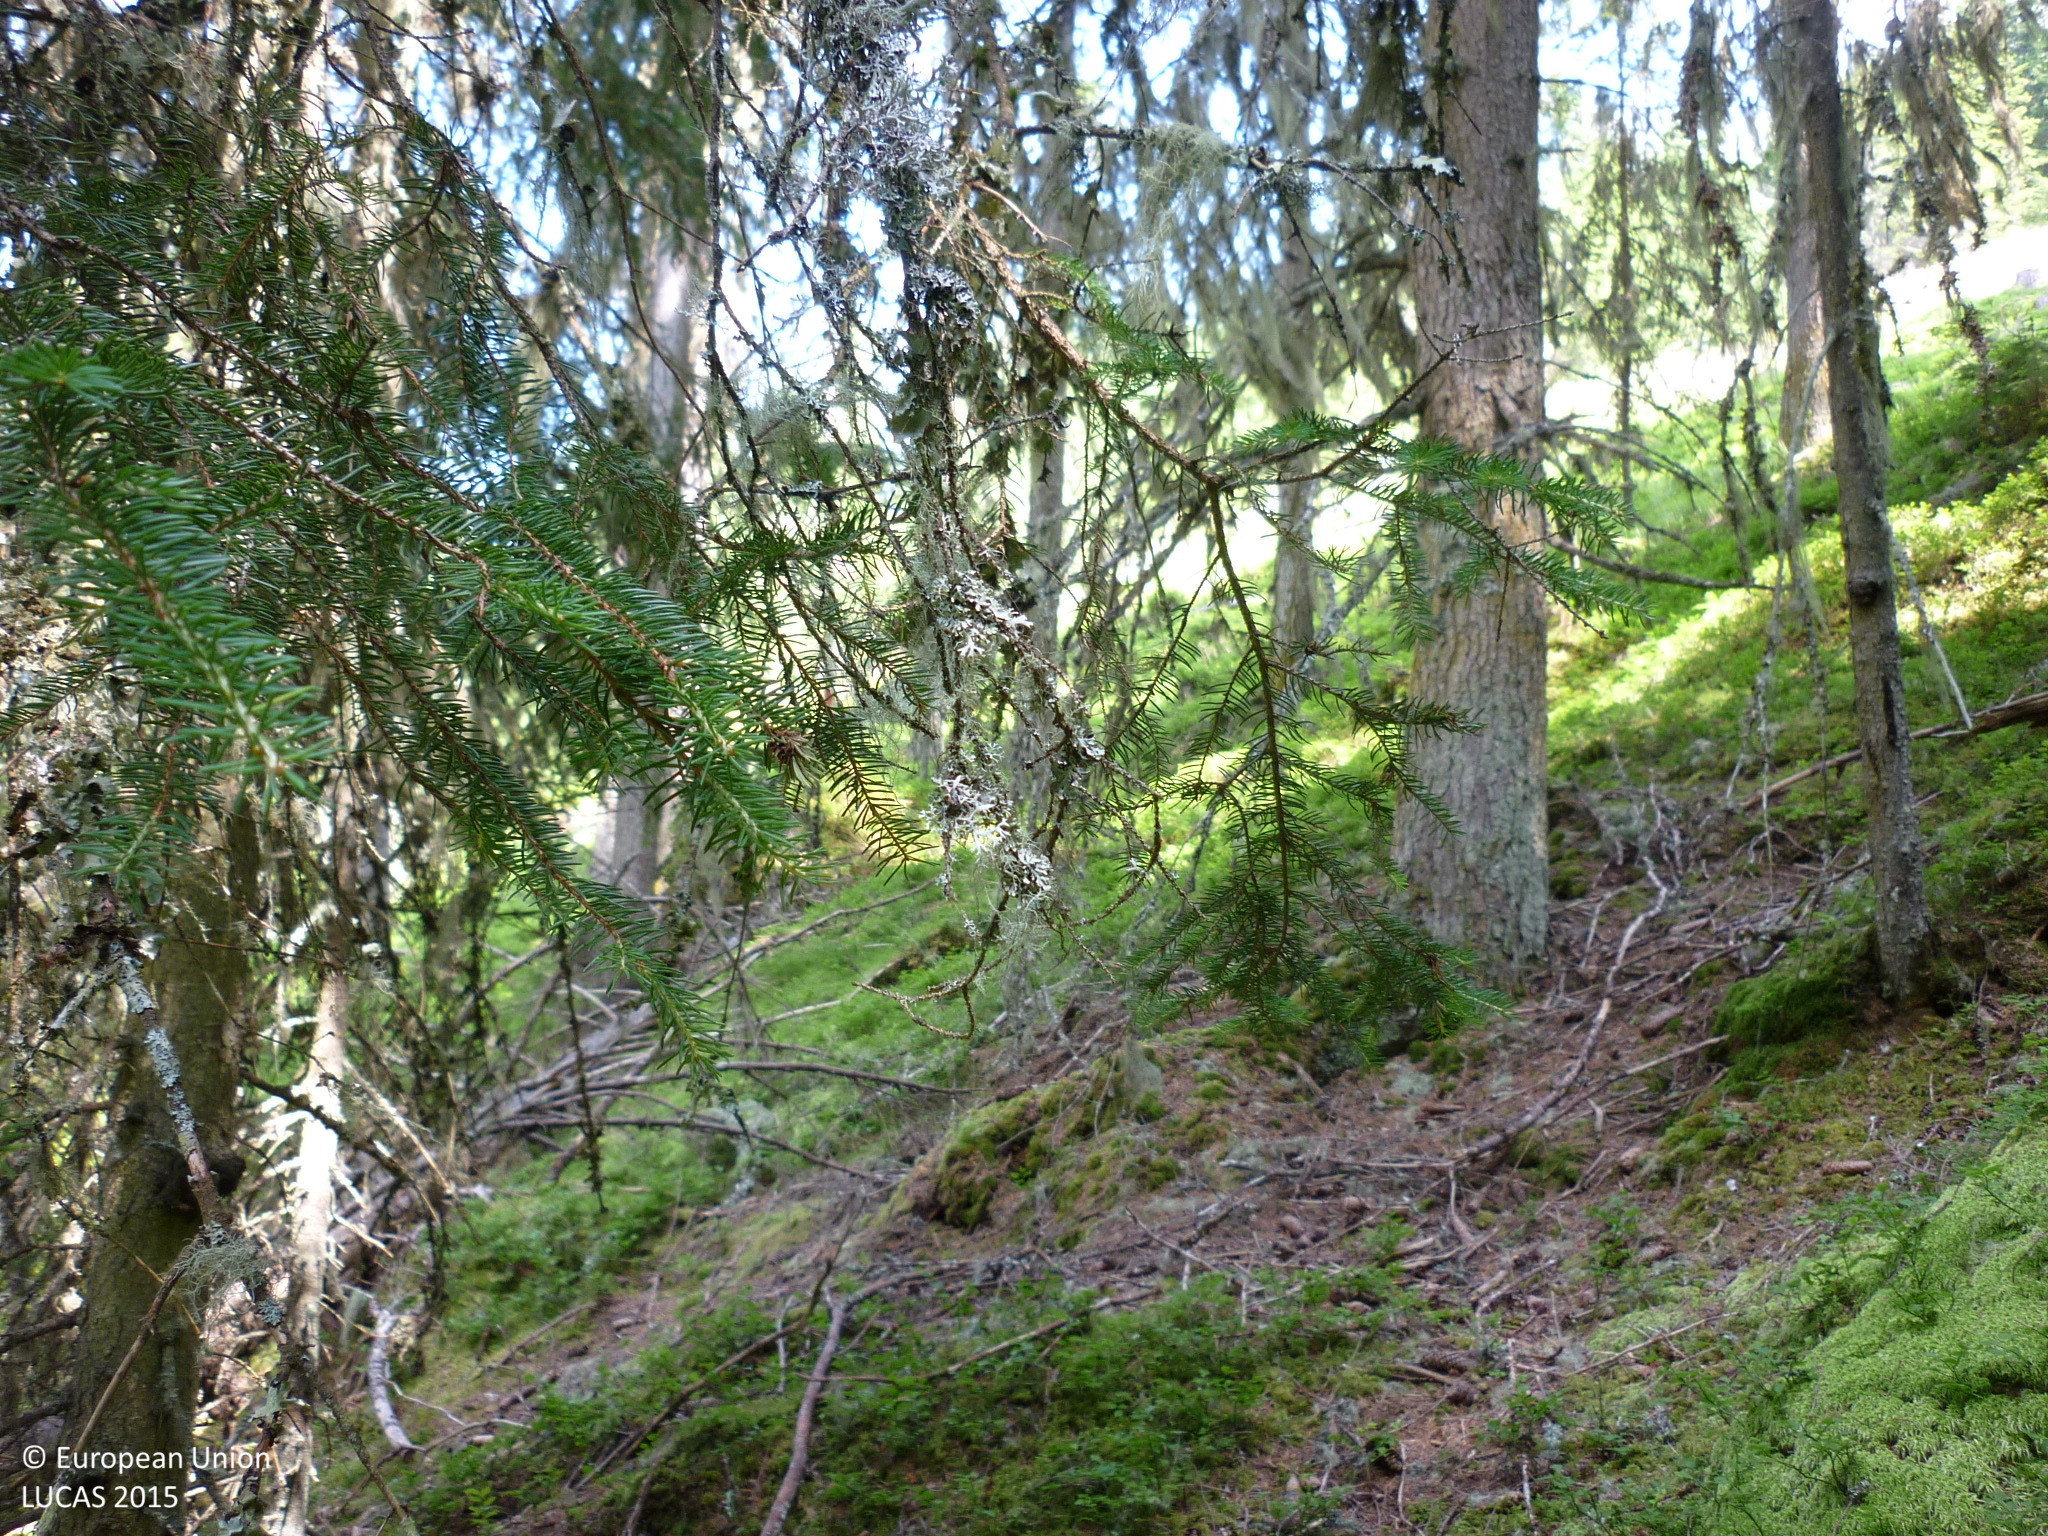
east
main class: Woodland
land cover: Spruce dominated coniferous woodland
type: alpine coniferous forest
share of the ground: > 75 %
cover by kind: coniferous forest trees 75 %, herbaceous plants 10 %, lichens and mosses 10 %, shrubs 5 %
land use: Forestry
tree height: > 5 m
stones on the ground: < 10 %
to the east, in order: Spruce dominated coniferous woodland; Other bare soil; Tracks; Spruce dominated coniferous woodland
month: July
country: AT
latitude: 47.3861
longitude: 13.7206
